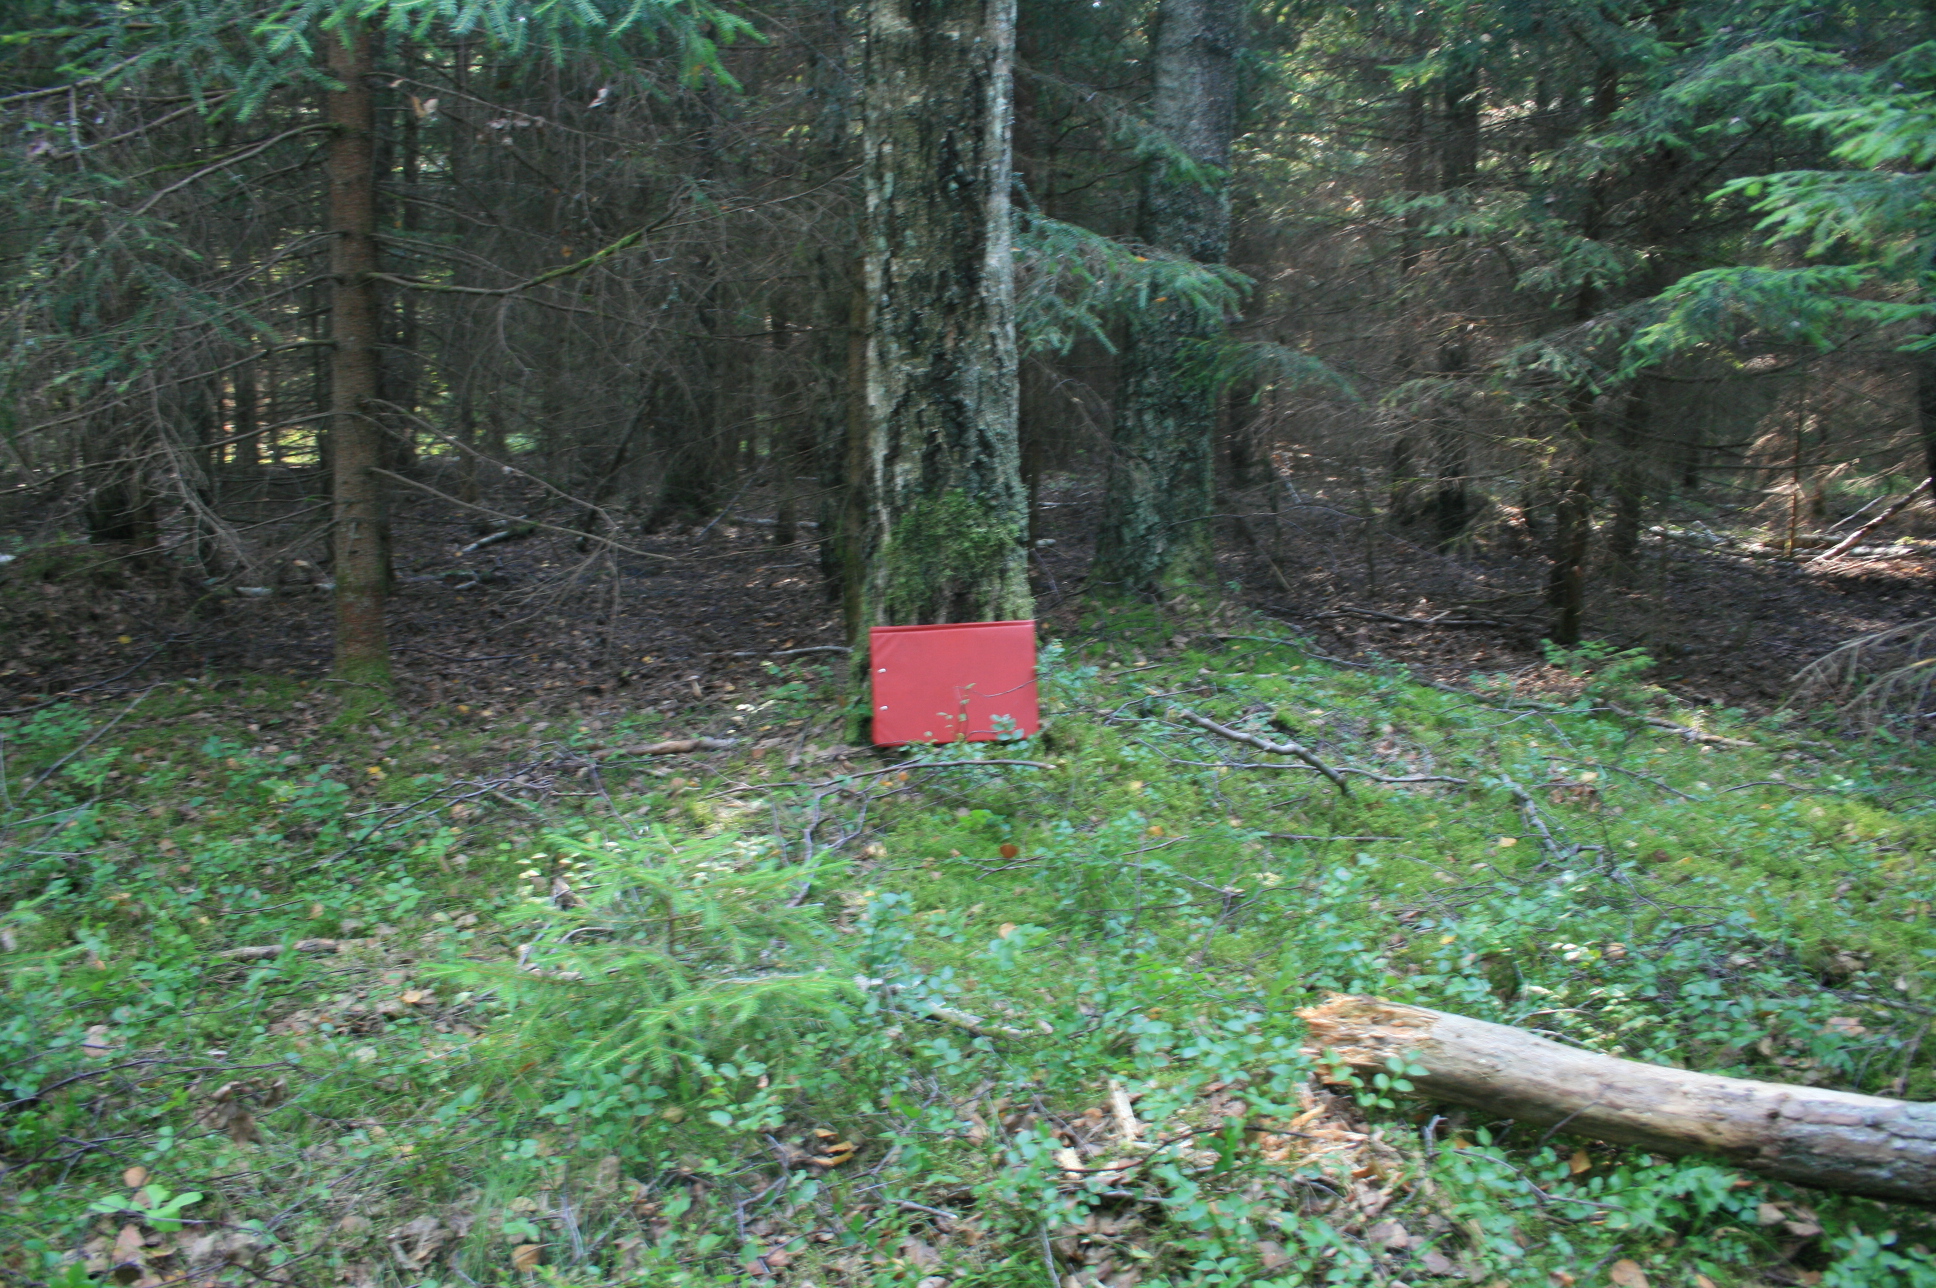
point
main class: Woodland
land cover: Spruce dominated mixed woodland
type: hemiboreal forest and nemoral coniferous forest and mixed broadleaved-coniferous forest
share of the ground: > 75 %
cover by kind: coniferous forest trees 60 %, broadleaved forest trees 30 %, shrubs 5 %, lichens and mosses 5 %
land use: Forestry
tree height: > 5 m
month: August
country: LT
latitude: 55.5178
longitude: 21.5607
